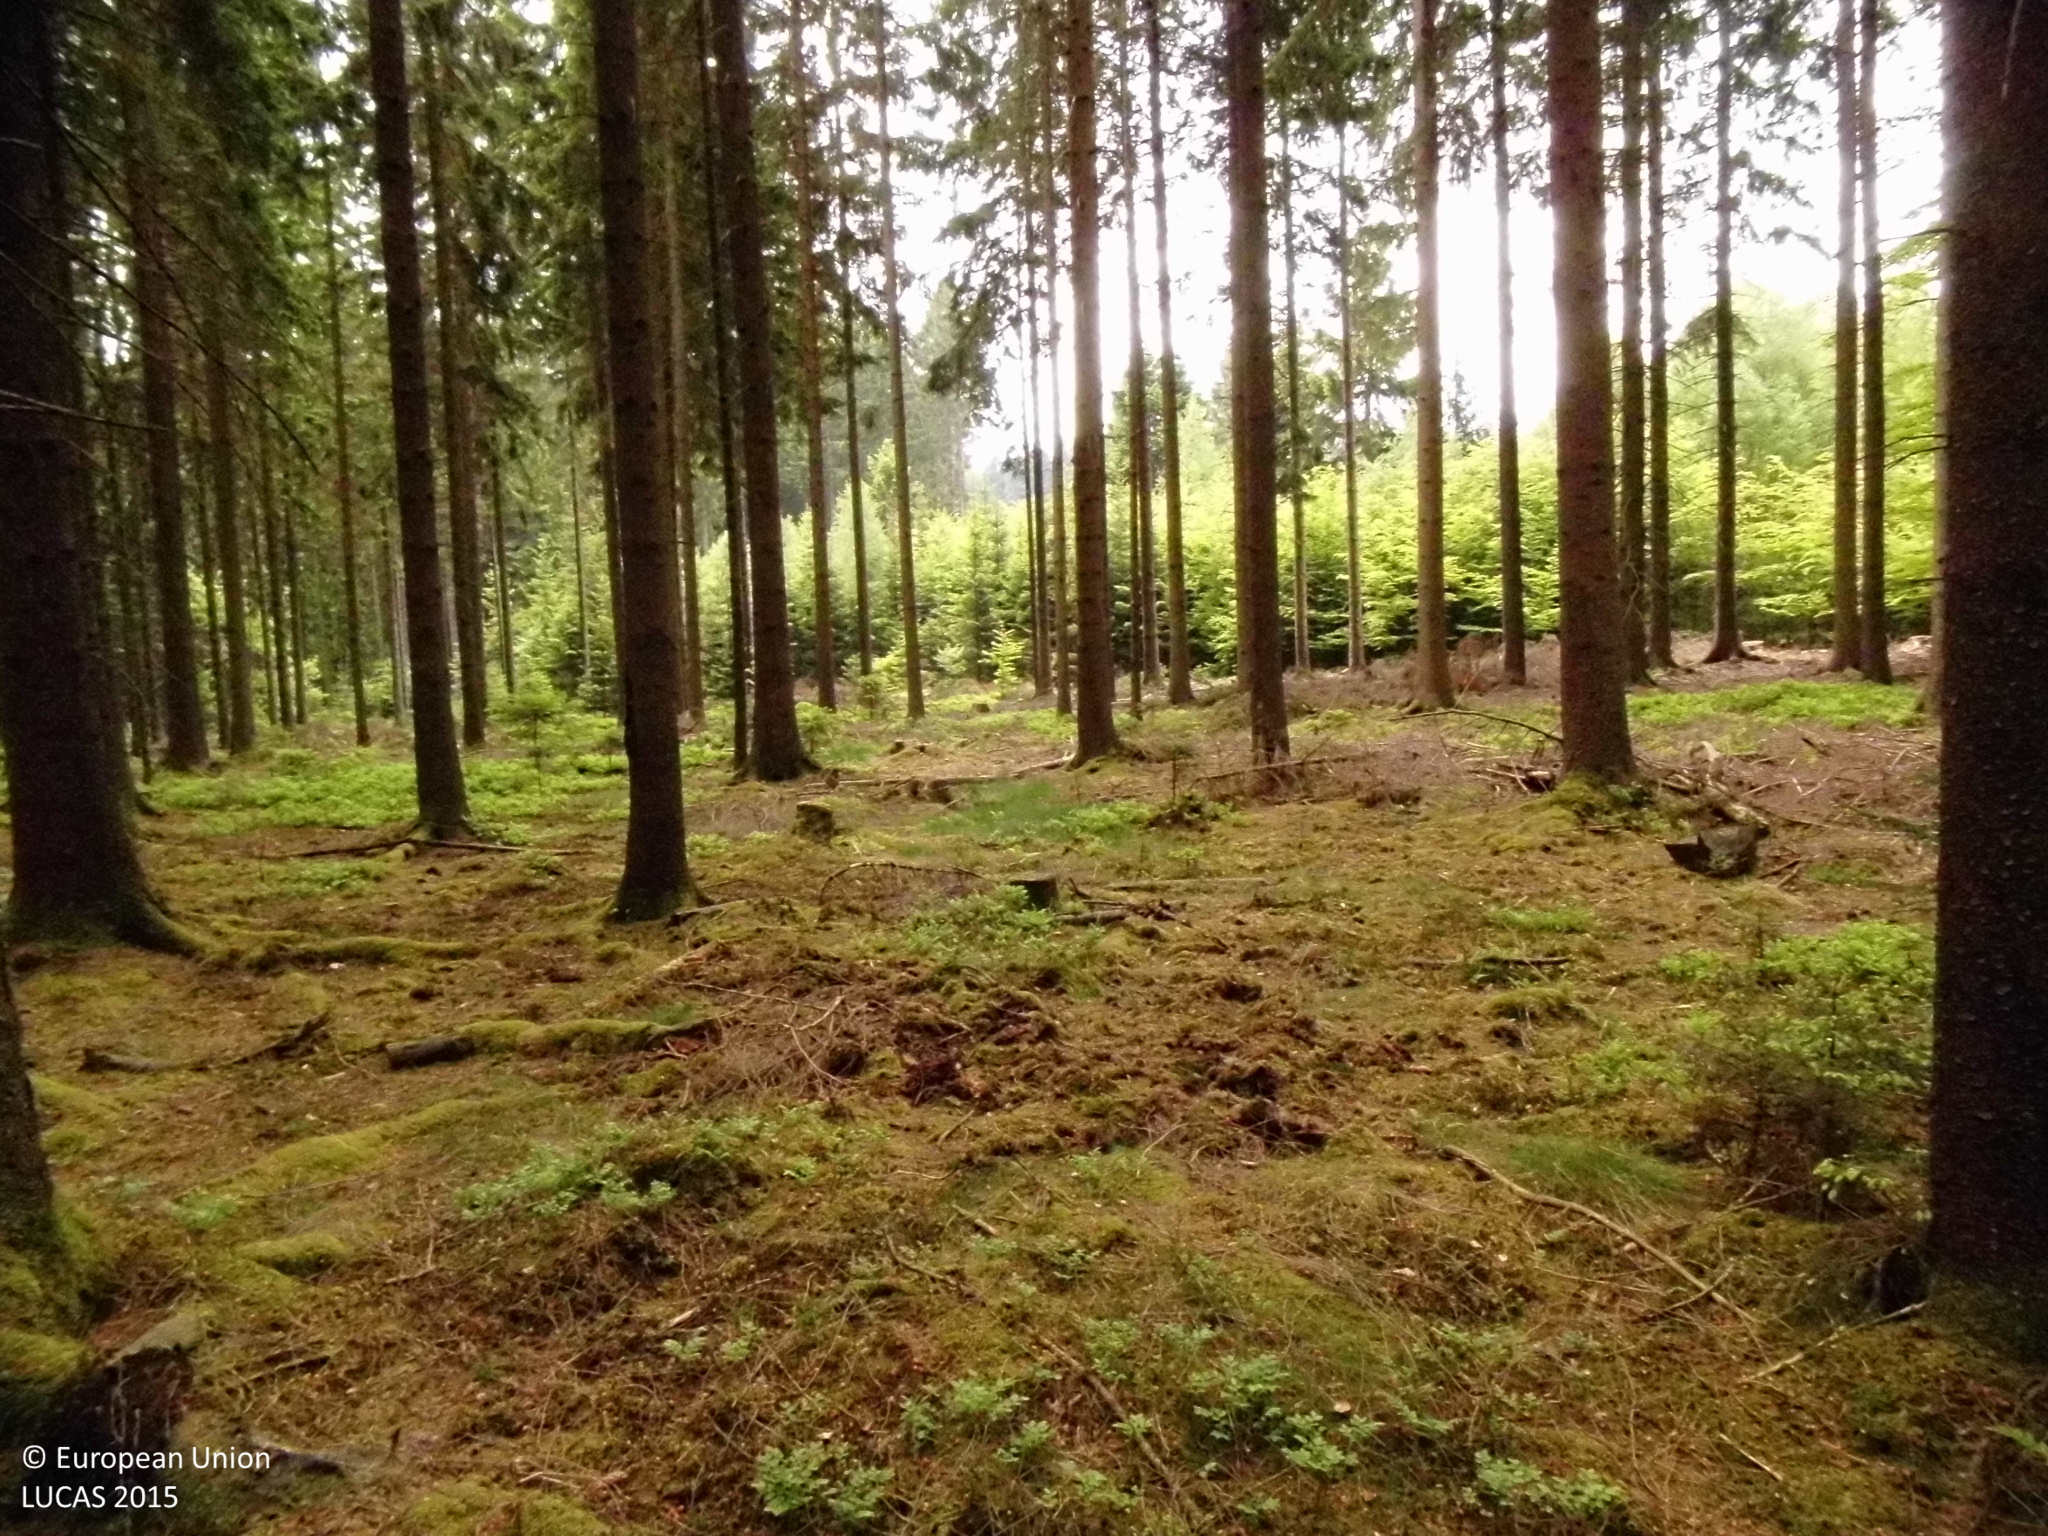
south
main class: Woodland
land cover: Spruce dominated coniferous woodland
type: hemiboreal forest and nemoral coniferous forest and mixed broadleaved-coniferous forest
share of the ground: > 75 %
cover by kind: coniferous forest trees 85 %, lichens and mosses 10 %, herbaceous plants 5 %
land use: Forestry
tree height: > 5 m
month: May
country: DE
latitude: 50.7330
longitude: 7.5208
